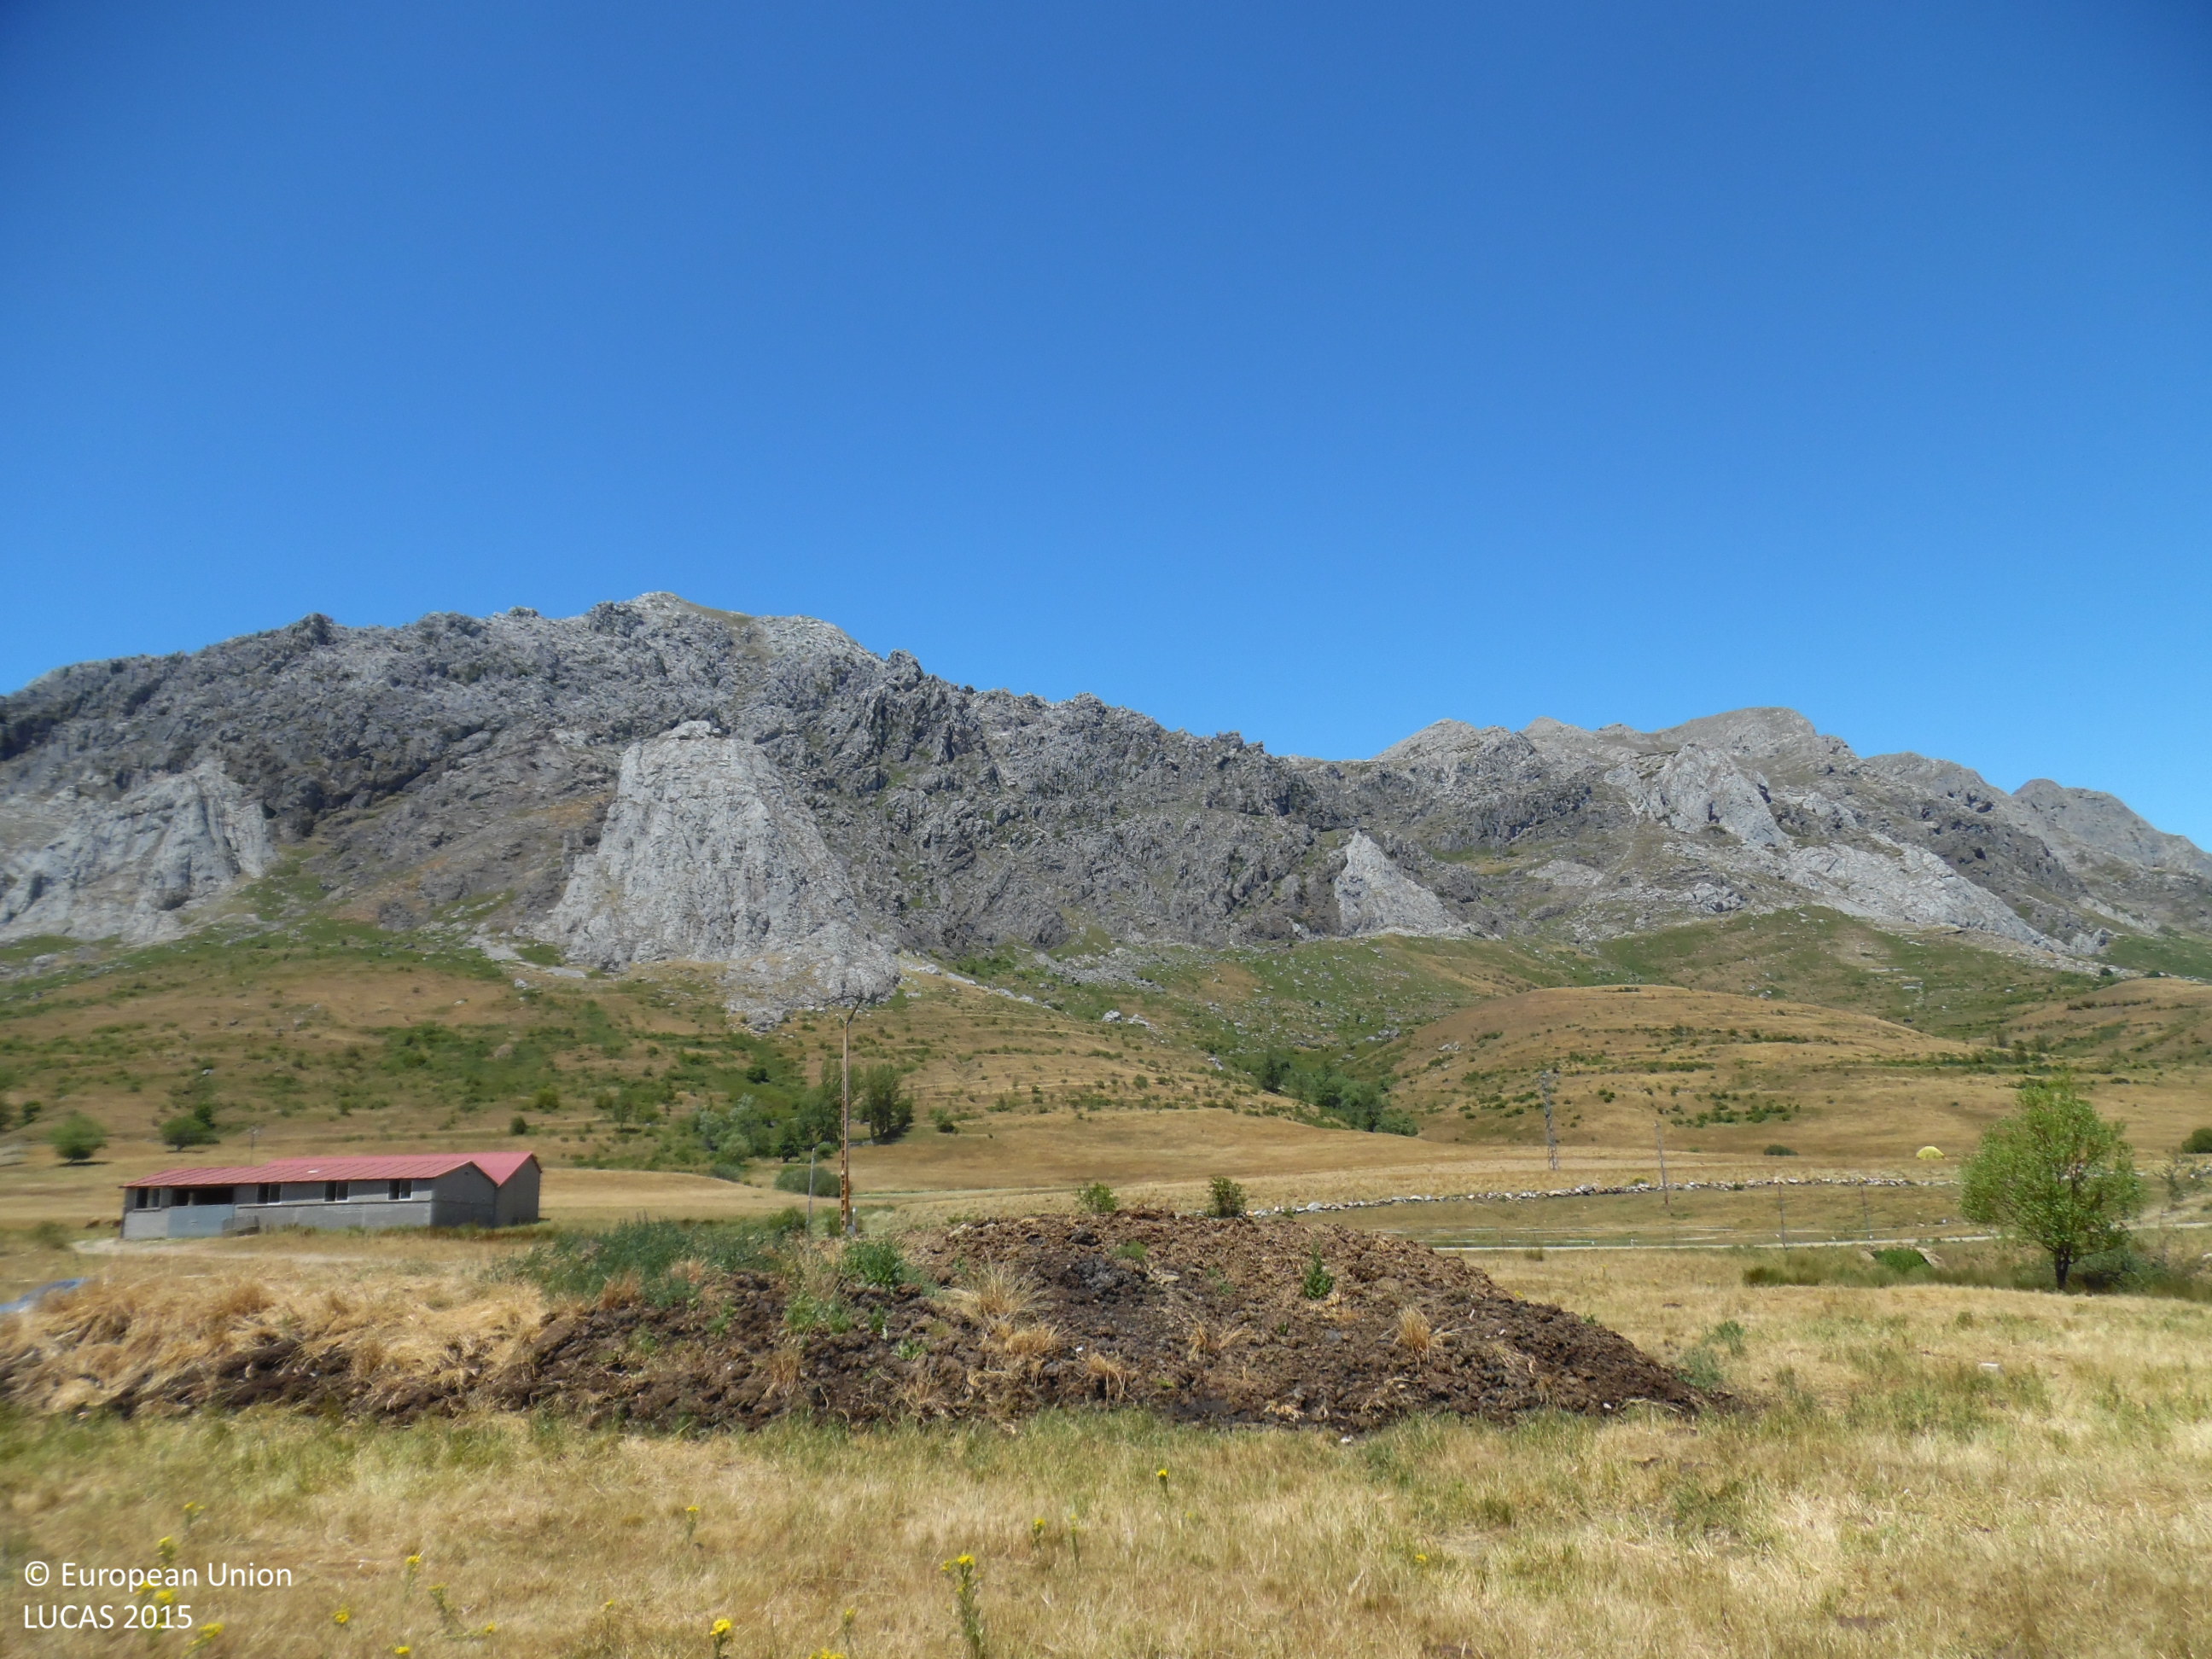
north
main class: Grassland
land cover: Grassland without tree/shrub cover
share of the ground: > 75 %
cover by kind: herbaceous plants 100 %
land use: Agriculture (excluding fallow land and kitchen gardens)
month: July
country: ES
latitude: 42.9287
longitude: -5.8017
